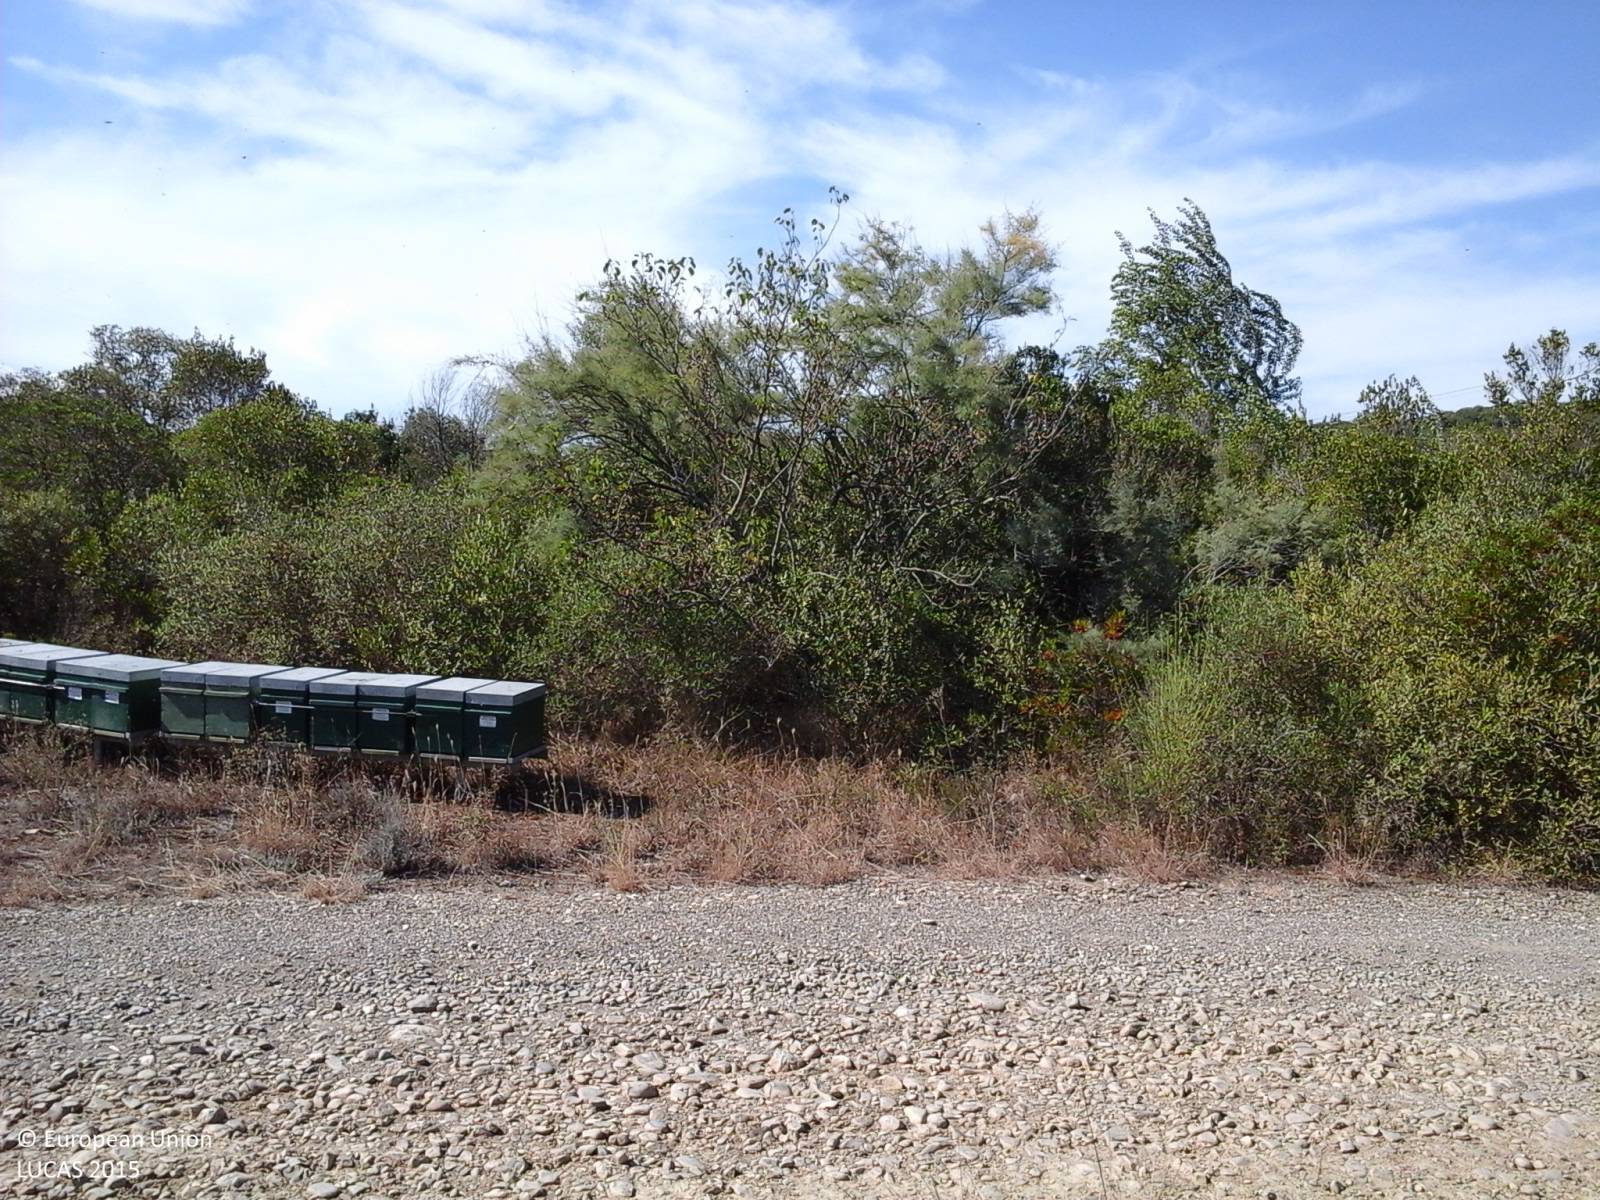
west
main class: Shrubland
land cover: Shrubland with sparse tree cover
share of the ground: > 75 %
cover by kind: shrubs 95 %, broadleaved forest trees 5 %
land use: Semi-natural and natural areas not in use
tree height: < 5 m
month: September
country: IT
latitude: 43.1029
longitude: 10.7227
